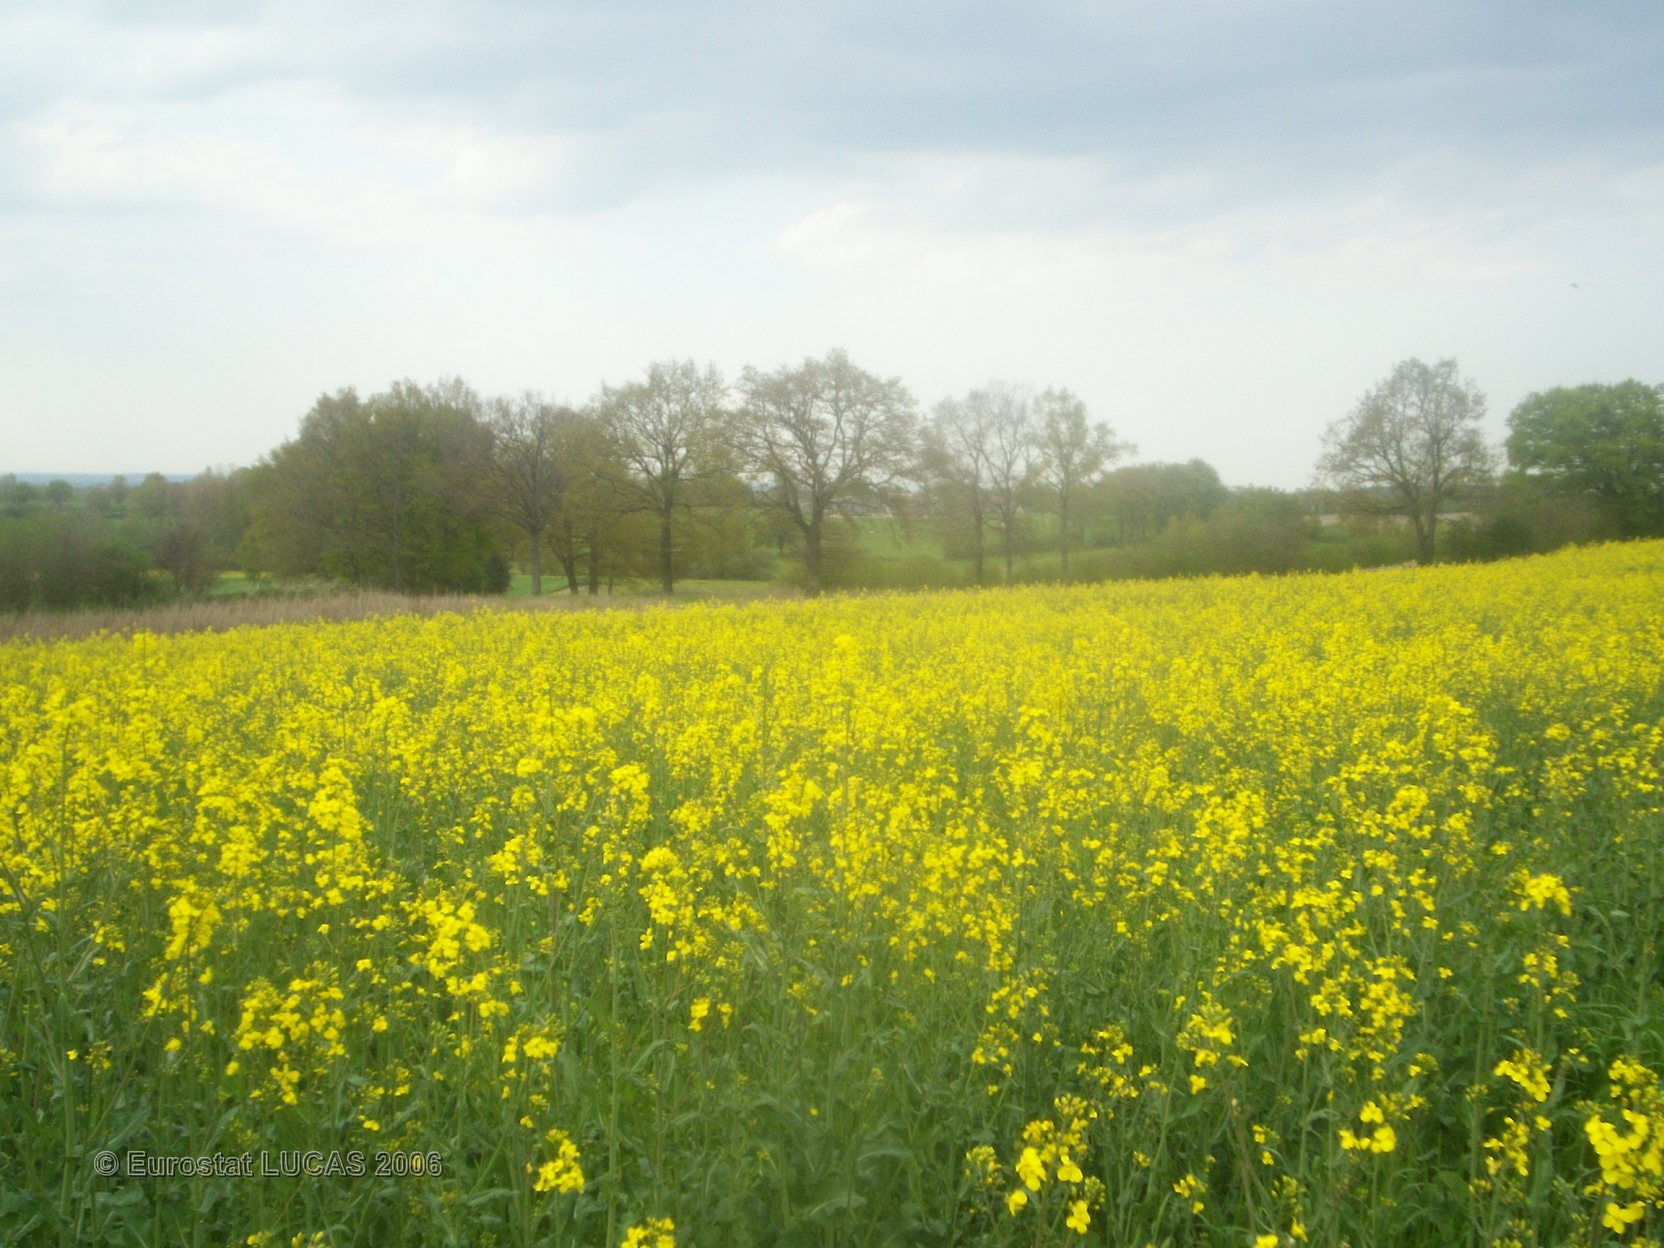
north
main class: Cropland
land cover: Rape and turnip rape
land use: Agriculture (excluding fallow land and kitchen gardens)
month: May
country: FR
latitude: 46.4705
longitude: 3.0822
